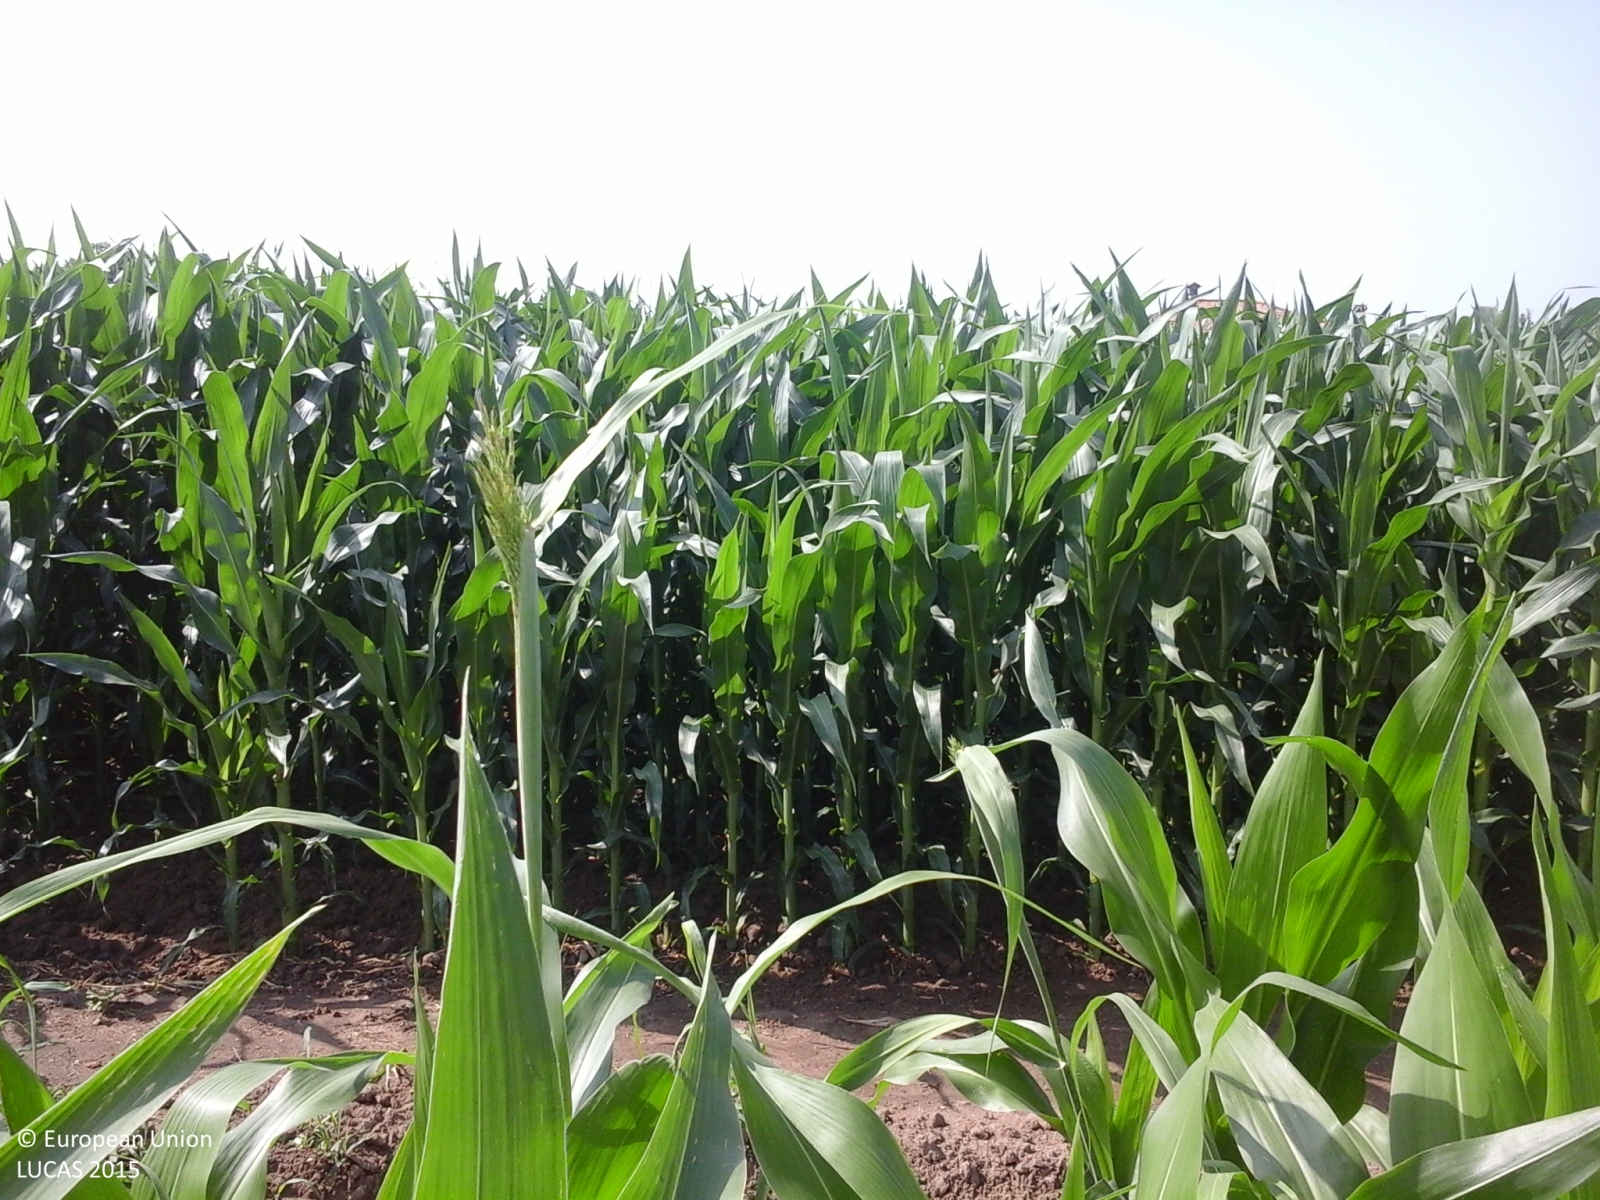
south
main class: Cropland
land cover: Maize
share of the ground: > 75 %
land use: Agriculture (excluding fallow land and kitchen gardens)
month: June
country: IT
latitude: 45.2102
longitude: 11.1057
